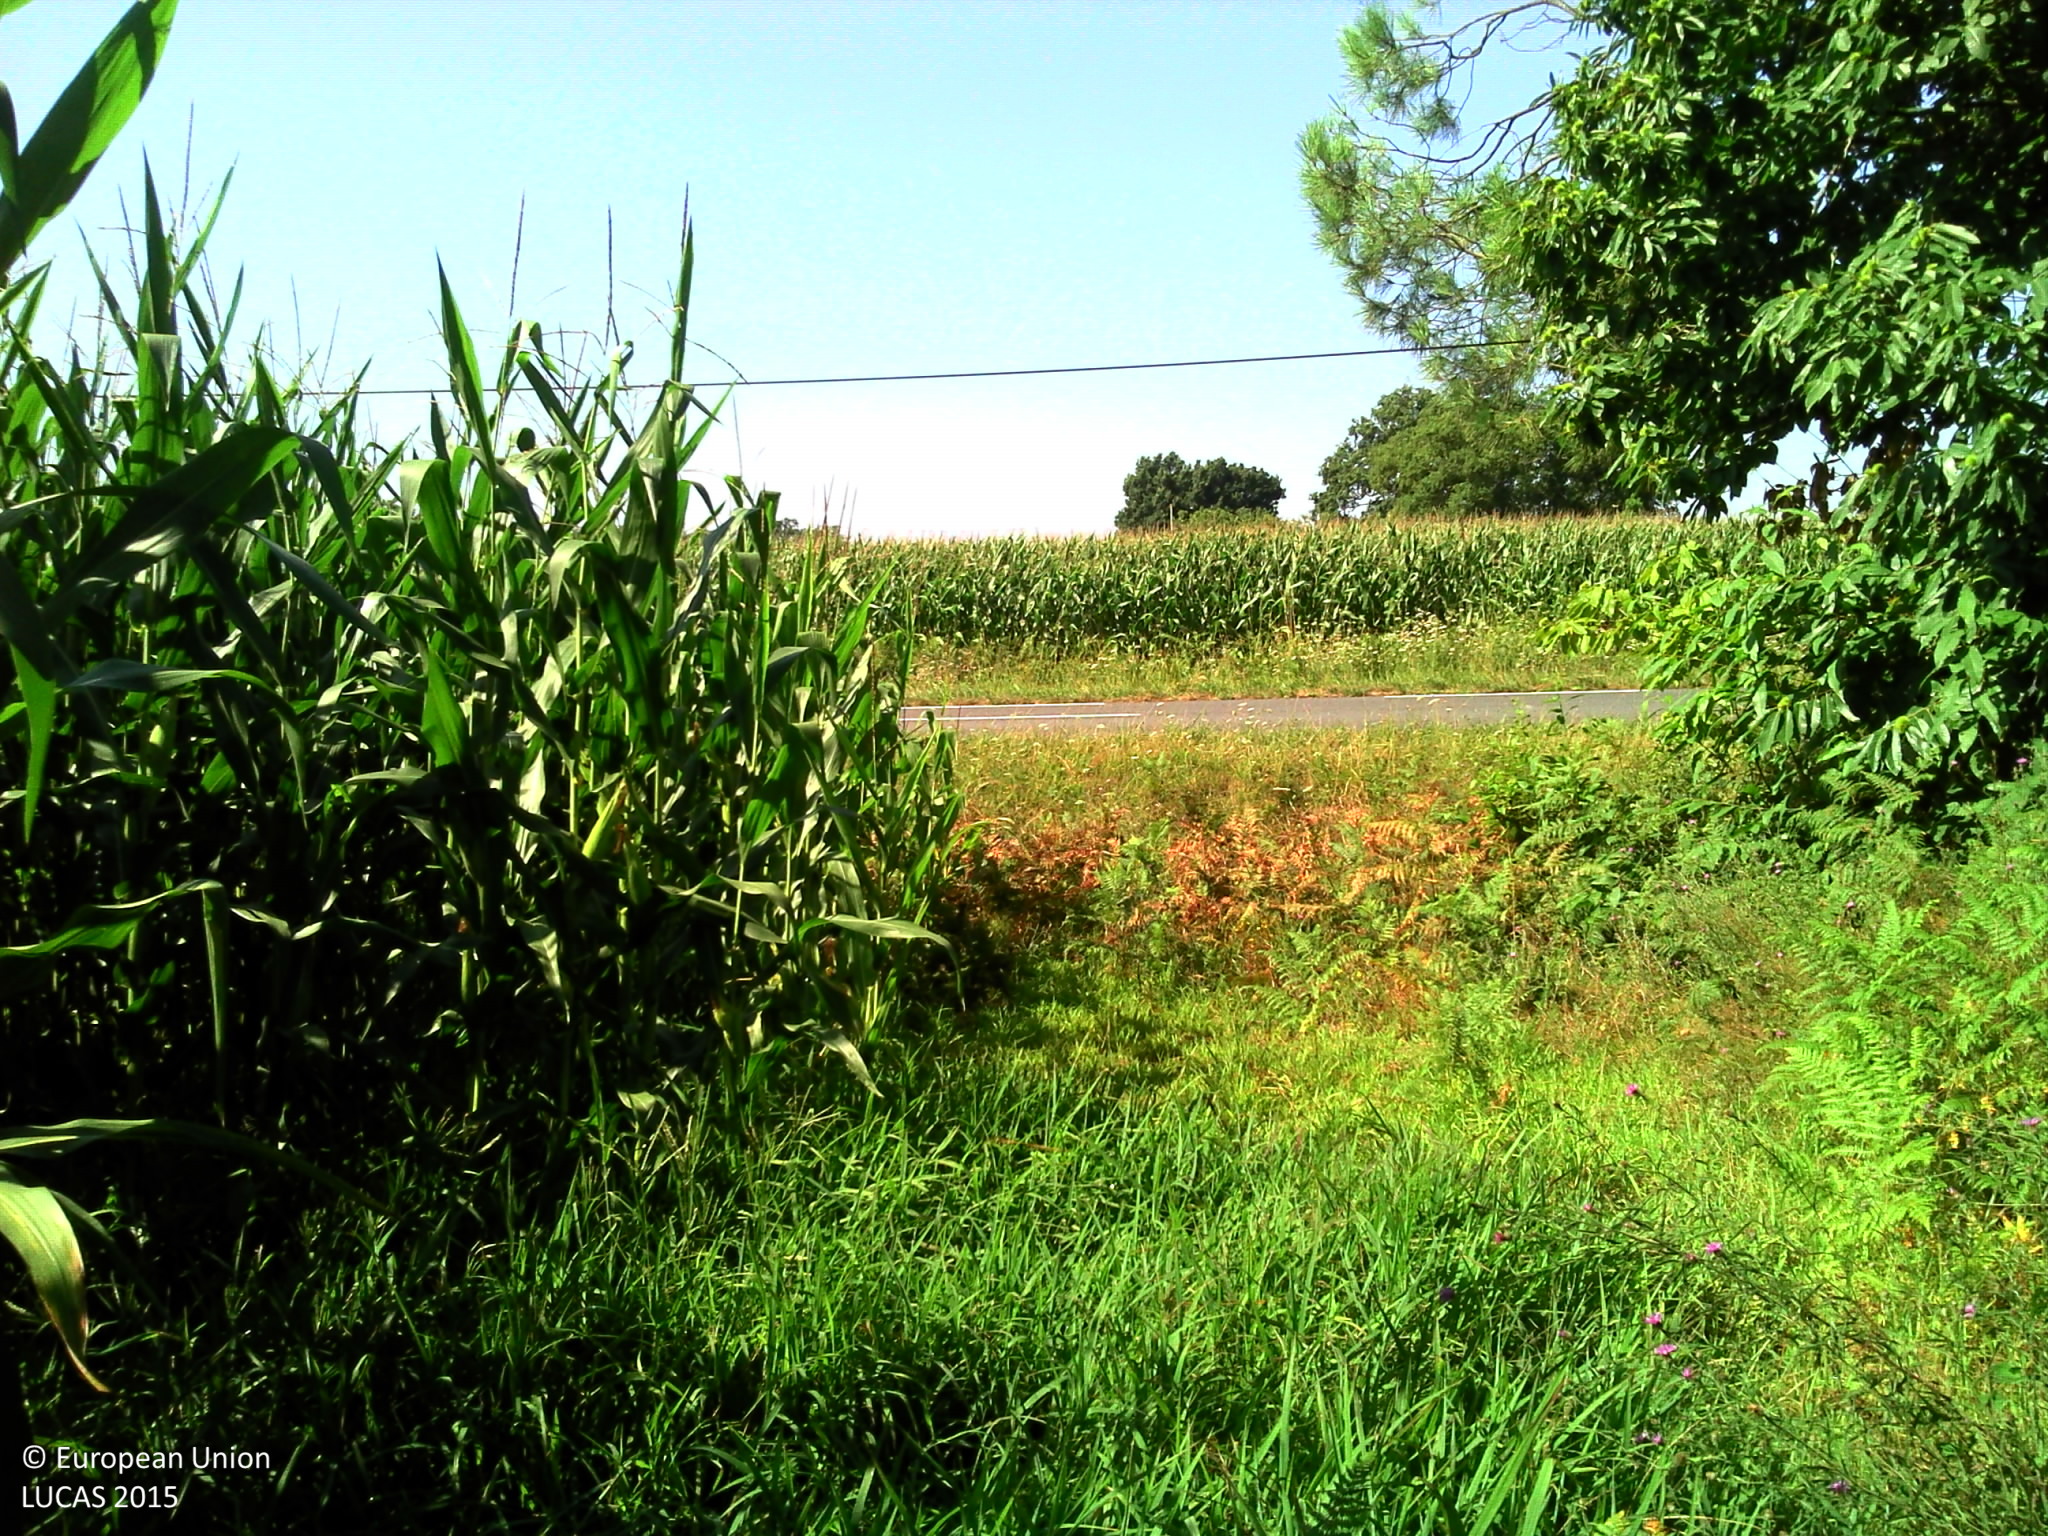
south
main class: Woodland
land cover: Pine dominated coniferous woodland
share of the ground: > 75 %
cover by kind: coniferous forest trees 80 %, herbaceous plants 15 %, shrubs 5 %
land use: Forestry
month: August
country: FR
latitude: 43.8070
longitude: -0.7662
